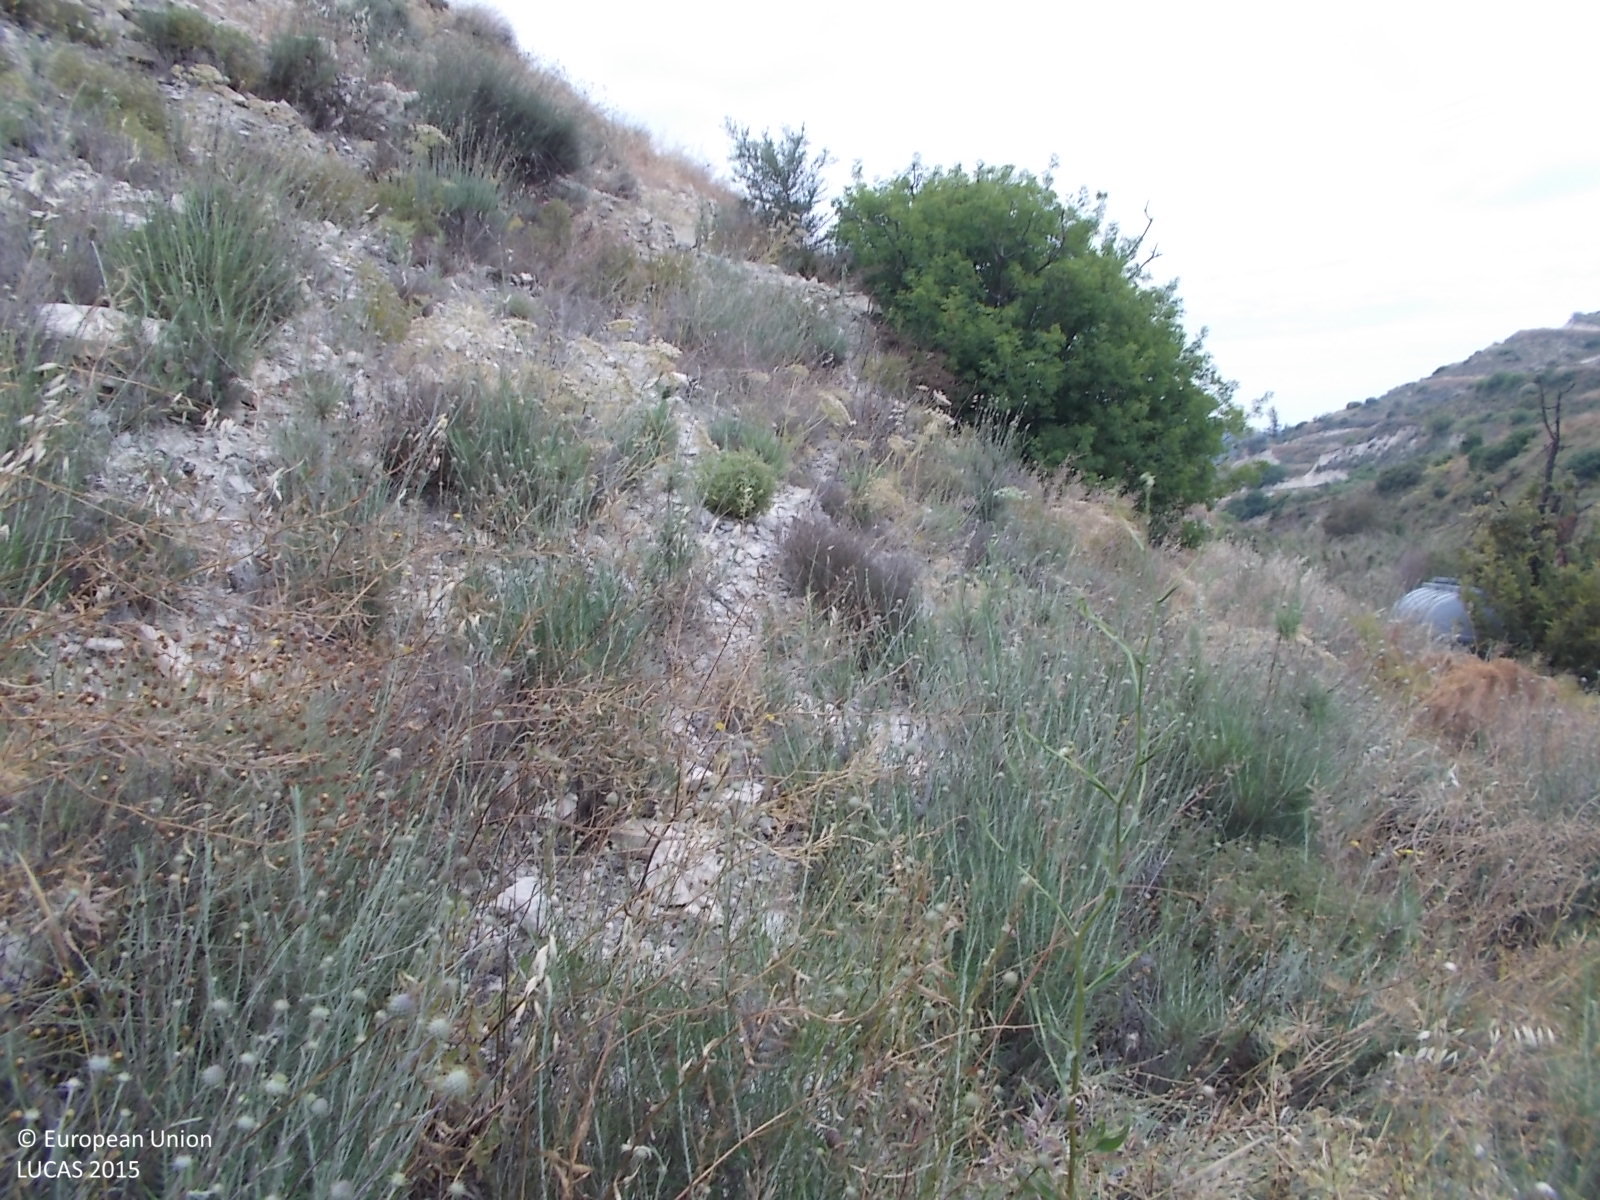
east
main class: Shrubland
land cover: Shrubland with sparse tree cover
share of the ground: > 75 %
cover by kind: shrubs 80 %, unconsolidated bare surface 15 %, broadleaved forest trees 5 %
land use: Semi-natural and natural areas not in use
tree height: < 5 m
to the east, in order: Shrubland with sparse tree cover; Dry stone walls; Grassland with sparse tree/shrub cover; Dry stone walls; Shrubland without tree cover; Spontaneously vegetated surfaces; Tracks; Shrubland without tree cover; Grassland with sparse tree/shrub cover; Spontaneously vegetated surfaces; Tracks; Shrubland without tree cover; Grassland without tree/shrub cover; Dry stone walls; Grassland with sparse tree/shrub cover; Grassland without tree/shrub cover
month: May
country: CY
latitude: 34.7760
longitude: 33.2884
